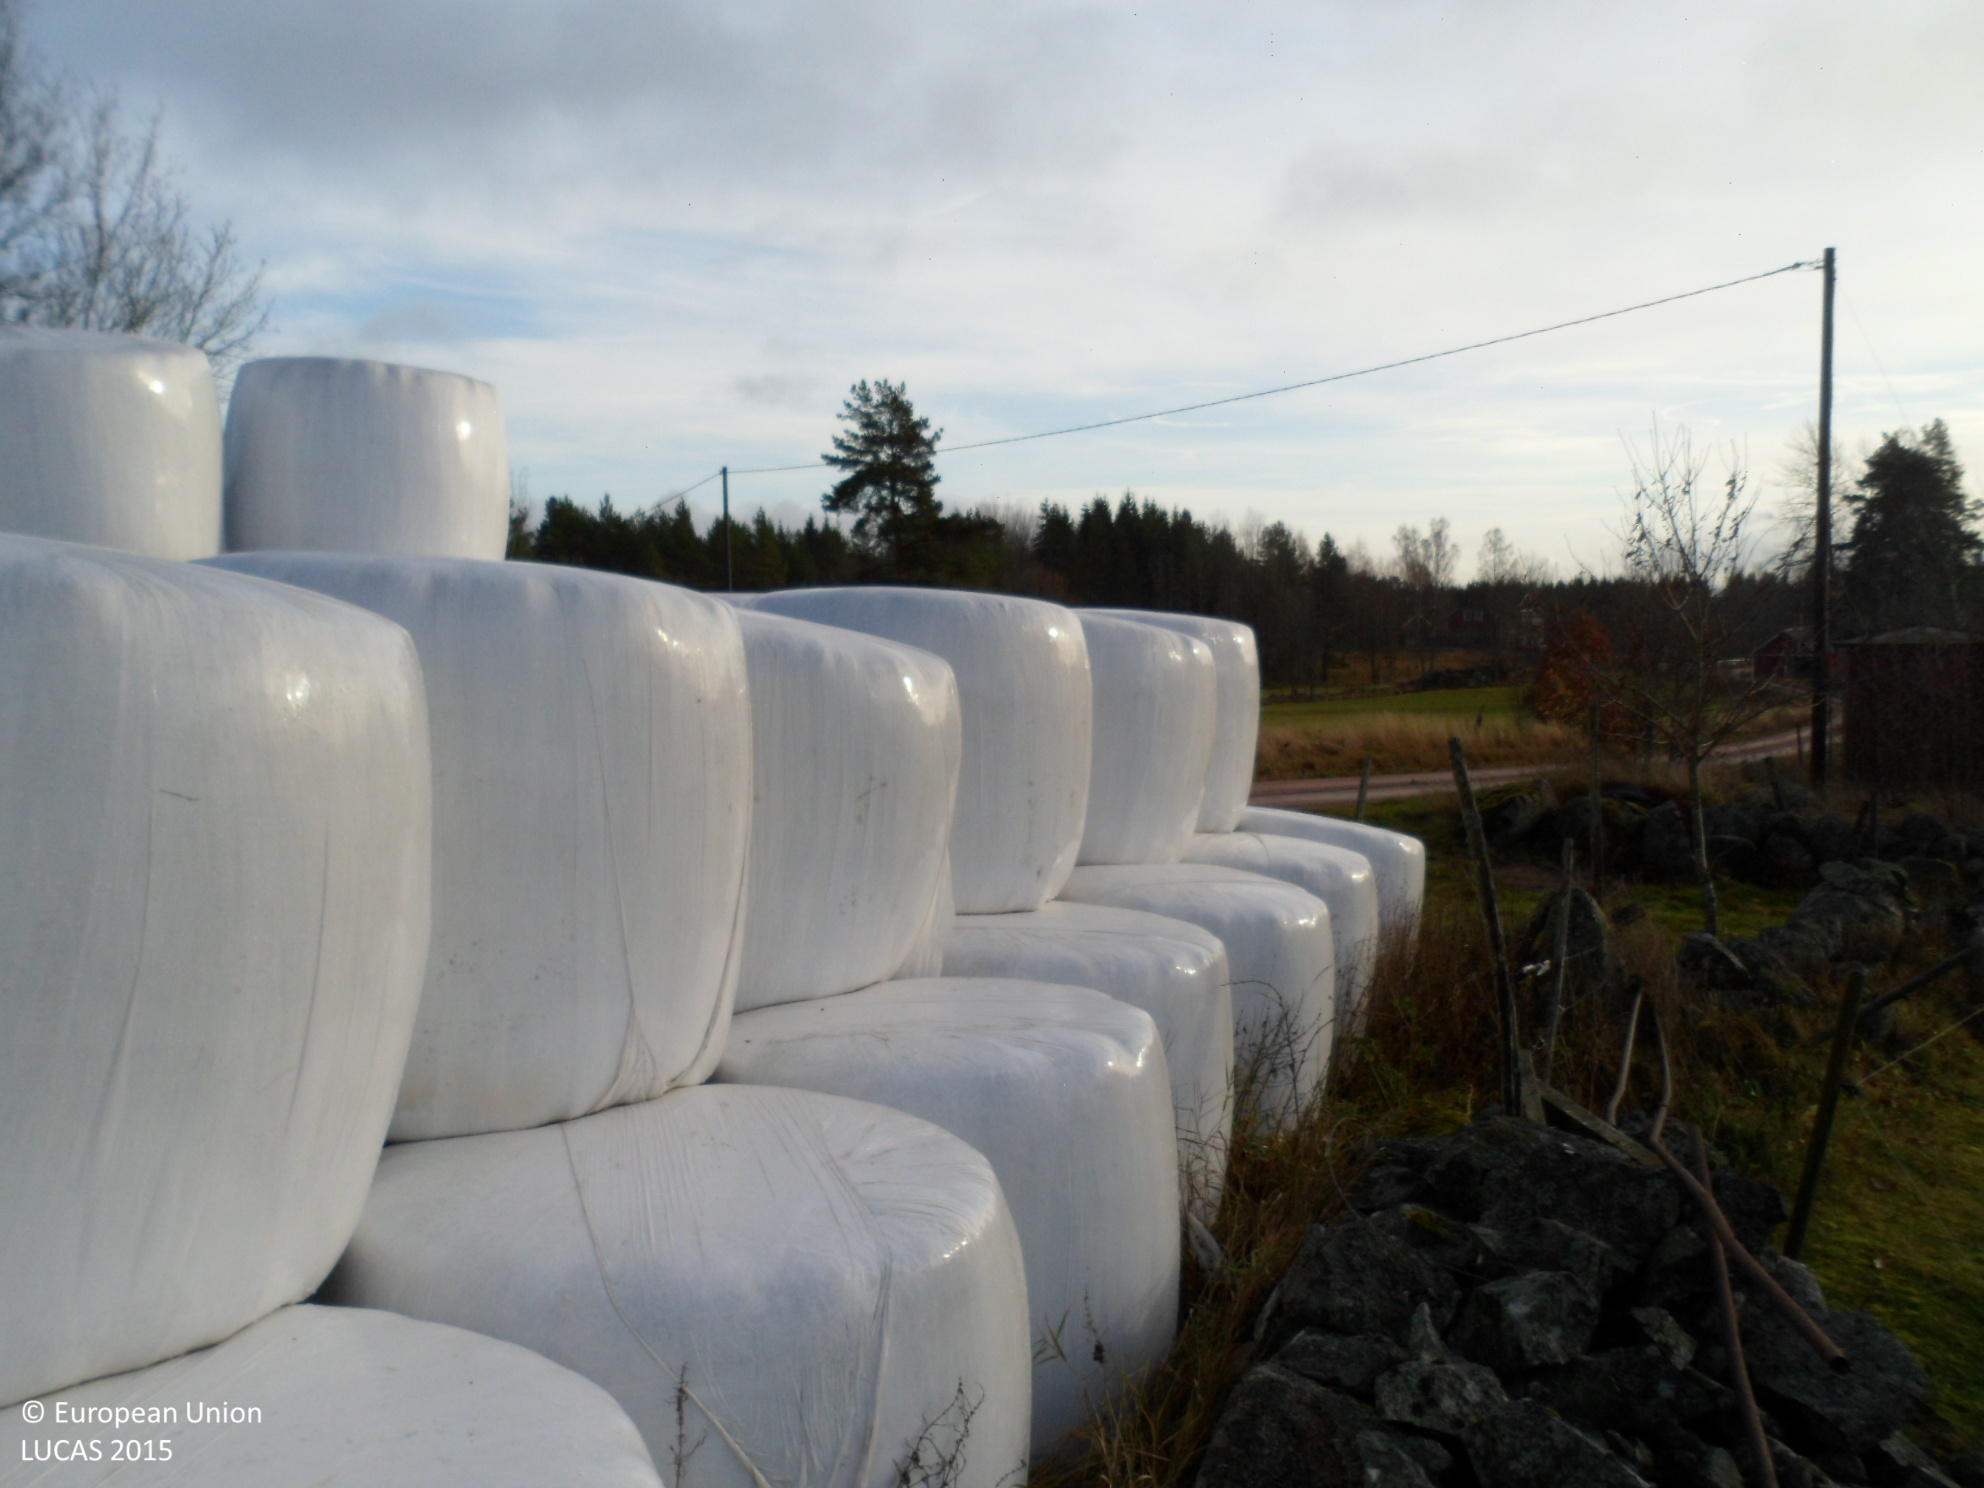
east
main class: Grassland
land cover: Grassland without tree/shrub cover
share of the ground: > 75 %
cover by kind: herbaceous plants 100 %
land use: Agriculture (excluding fallow land and kitchen gardens)
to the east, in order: Grassland without tree/shrub cover; Fences; Dry stone walls; Artificial constructions in urban areas; Dry stone walls; Groves; Grassland without tree/shrub cover; Dry stone walls; Fences; Grassland without tree/shrub cover; Electric lines; Broadleaved woodland
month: November
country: SE
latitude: 57.7275
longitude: 15.5208
